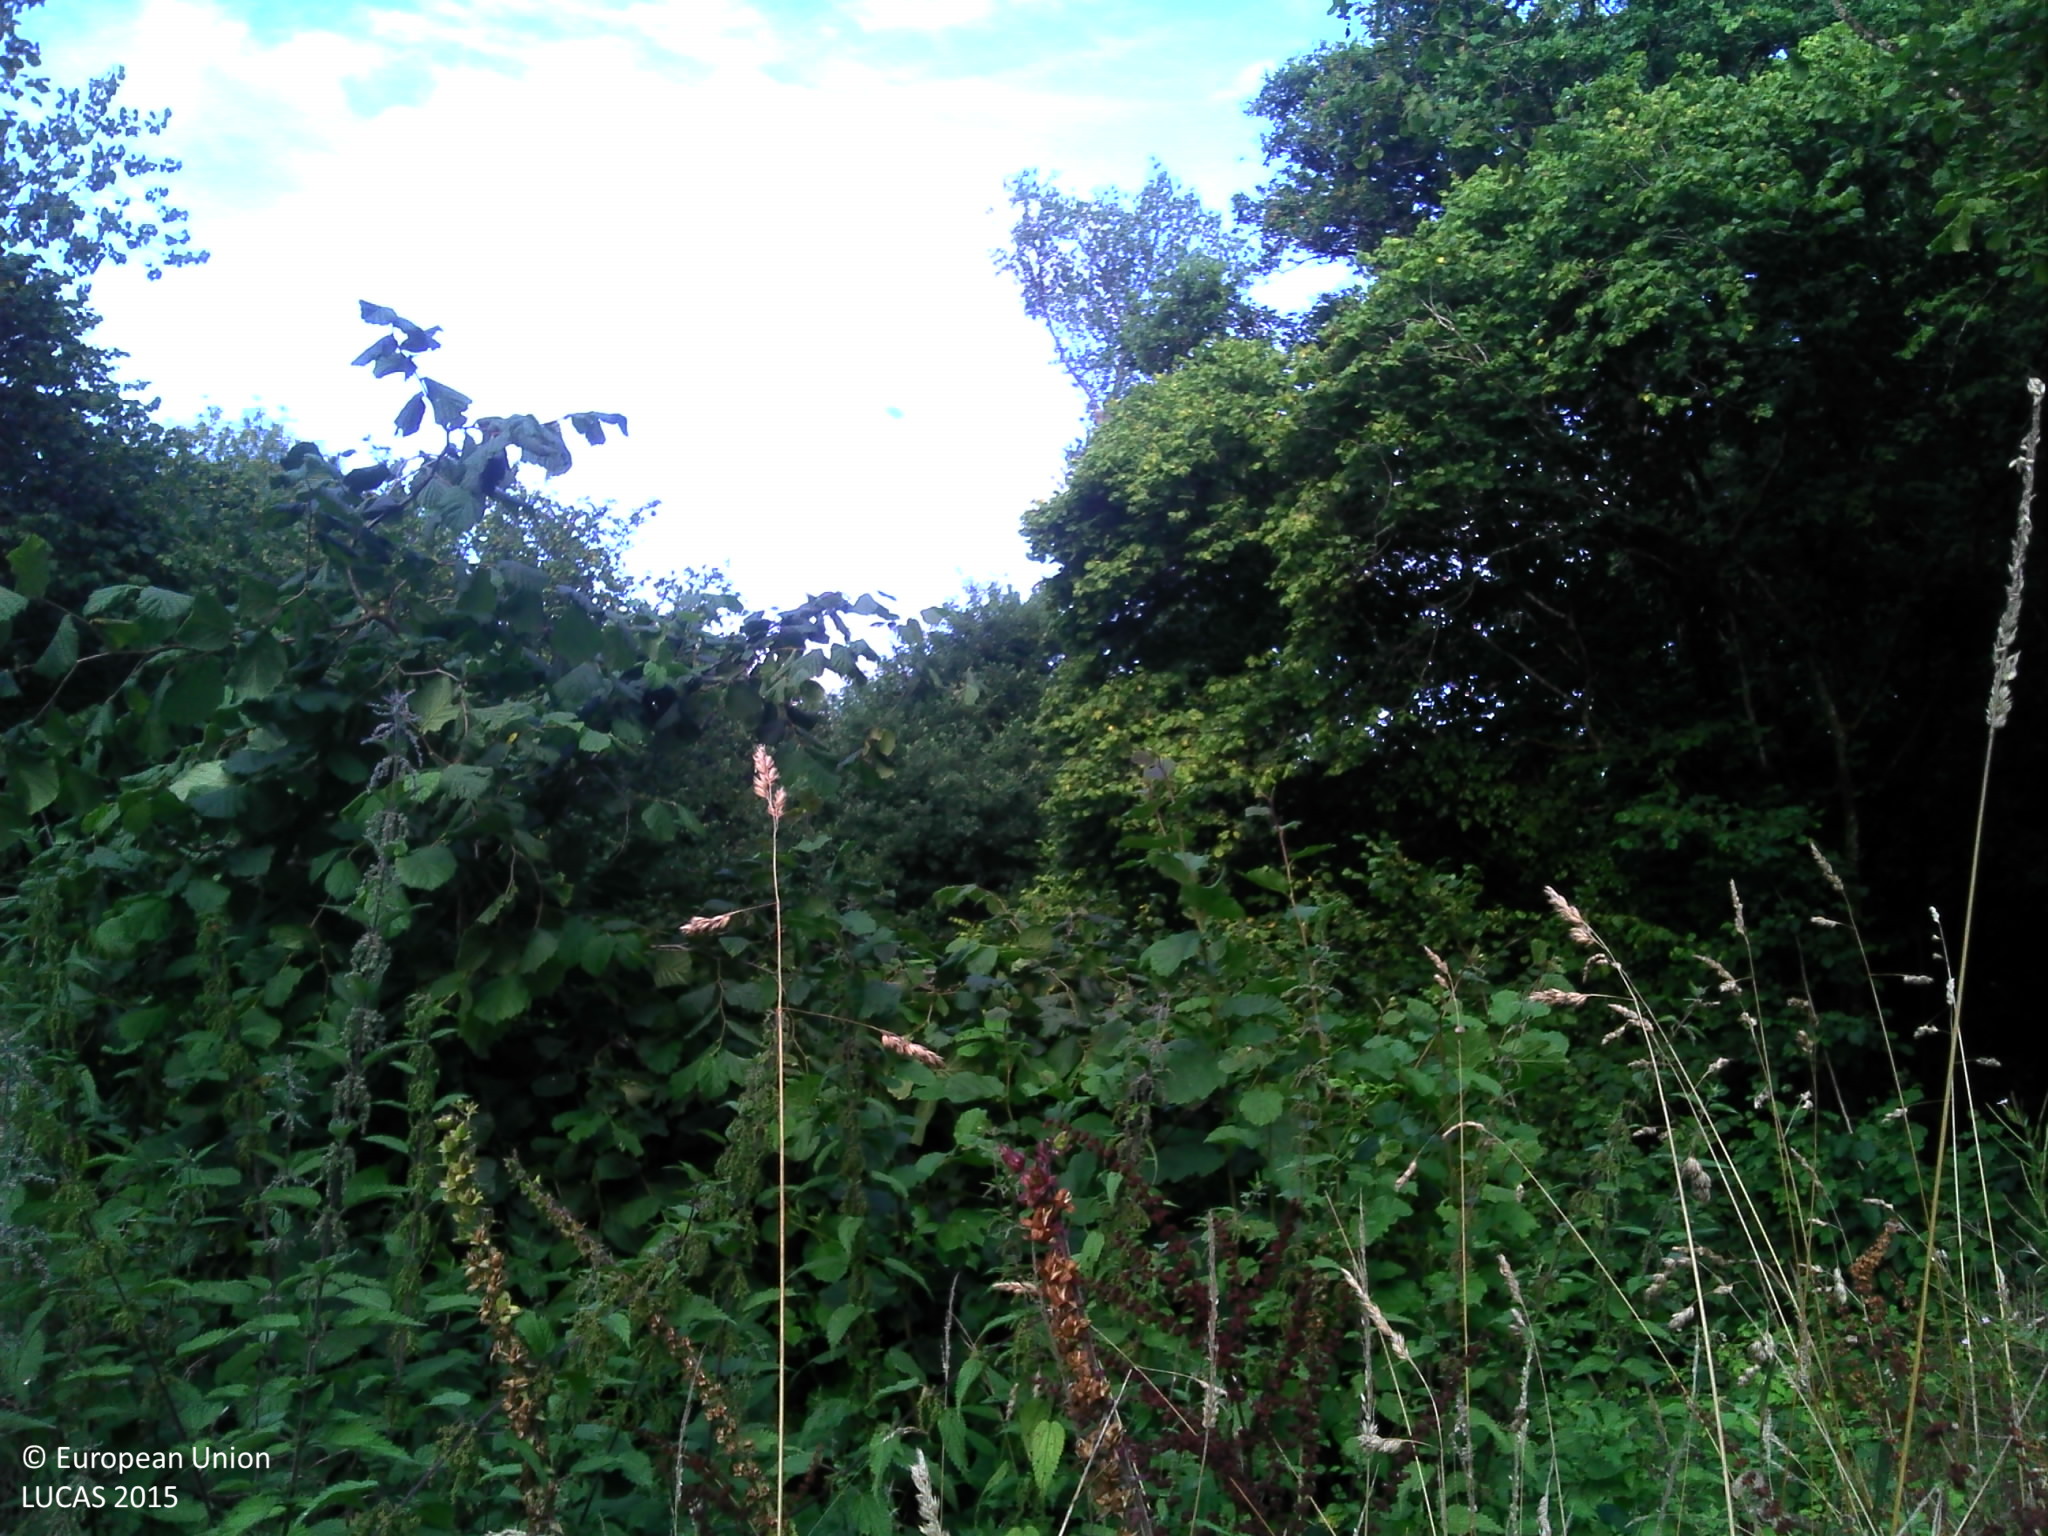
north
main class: Woodland
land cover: Broadleaved woodland
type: mesophytic deciduous forest
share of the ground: > 75 %
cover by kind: broadleaved forest trees 55 %, shrubs 25 %, herbaceous plants 20 %
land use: Semi-natural and natural areas not in use
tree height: > 5 m
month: August
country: FR
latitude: 48.3819
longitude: -3.4310
